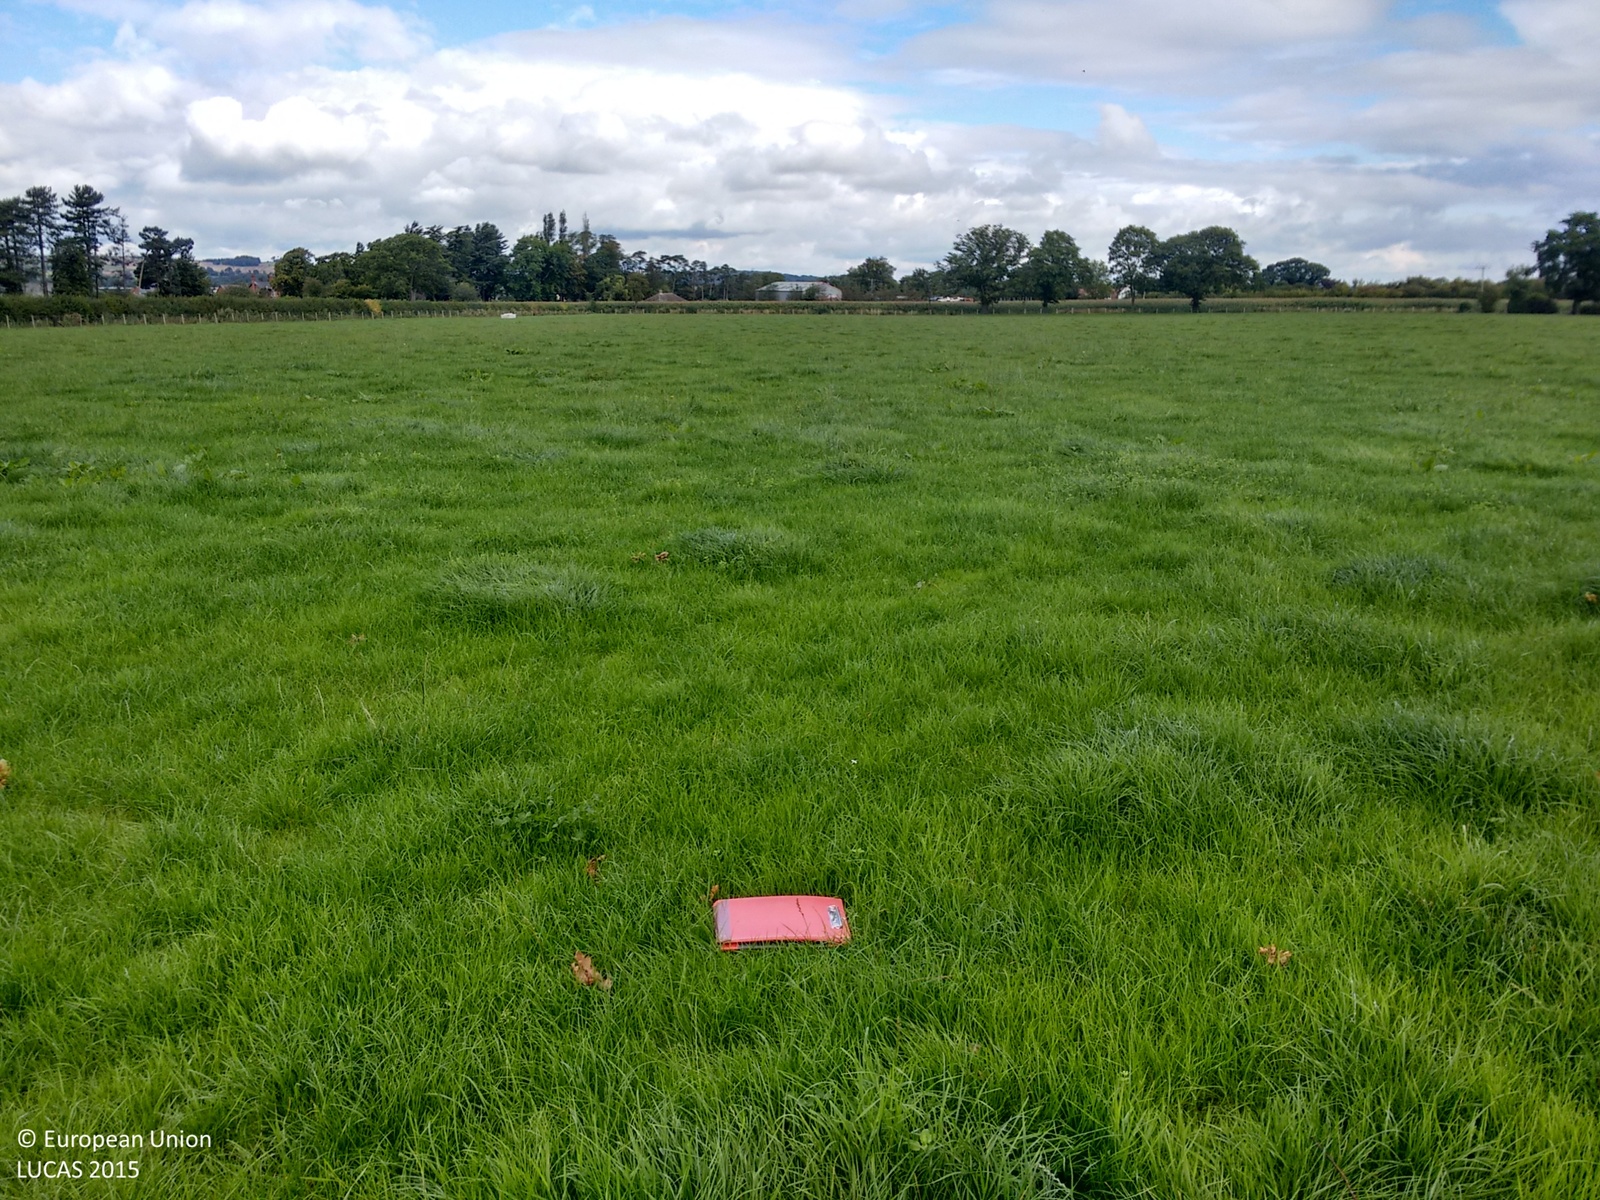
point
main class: Grassland
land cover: Grassland without tree/shrub cover
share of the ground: > 75 %
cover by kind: herbaceous plants 100 %
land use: Agriculture (excluding fallow land and kitchen gardens)
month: September
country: GB
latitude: 52.6307
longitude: -2.9426
